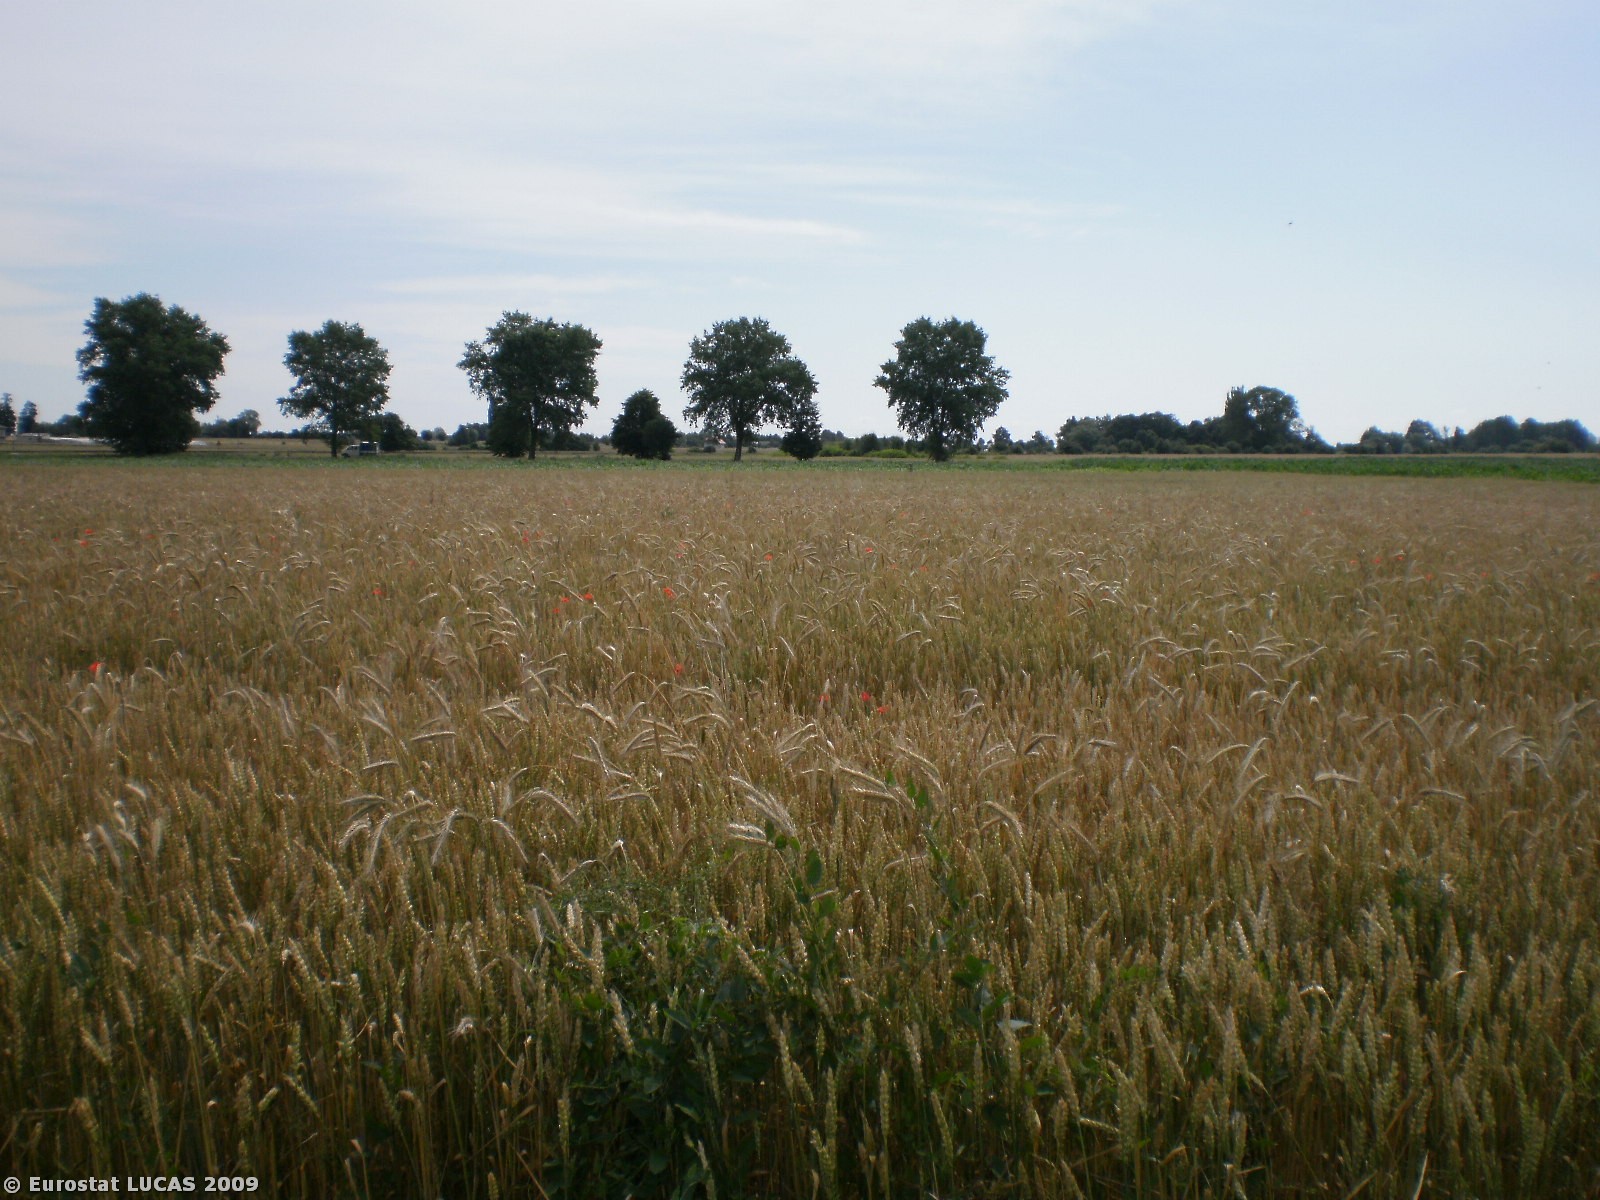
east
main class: Cropland
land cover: Other fresh vegetables
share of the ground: > 75 %
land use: Agriculture (excluding fallow land and kitchen gardens)
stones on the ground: < 10 %
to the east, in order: Other fresh vegetables; Grass margins; Common wheat; Maize
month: July
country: PL
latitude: 52.6500
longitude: 20.3386
